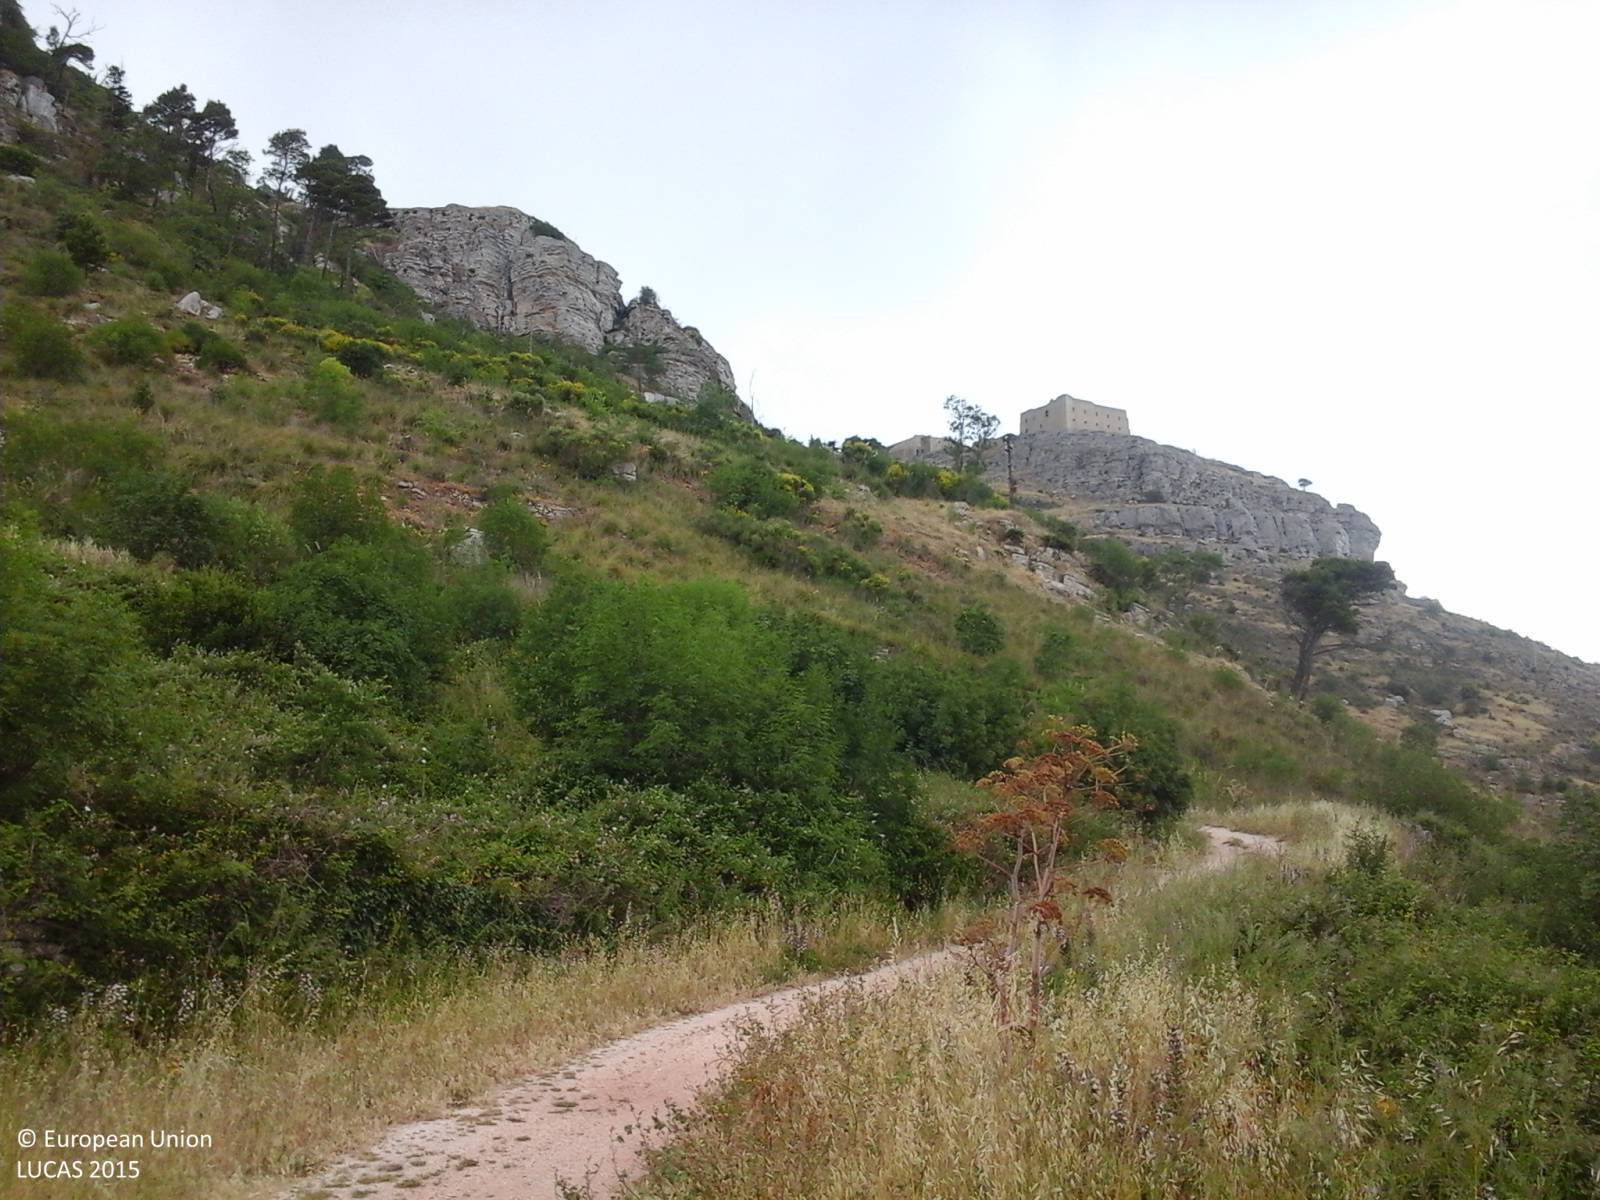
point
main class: Shrubland
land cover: Shrubland with sparse tree cover
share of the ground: > 75 %
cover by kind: herbaceous plants 85 %, shrubs 10 %, broadleaved forest trees 5 %
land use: Semi-natural and natural areas not in use
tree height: < 5 m
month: June
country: IT
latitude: 38.0391
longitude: 12.5905
